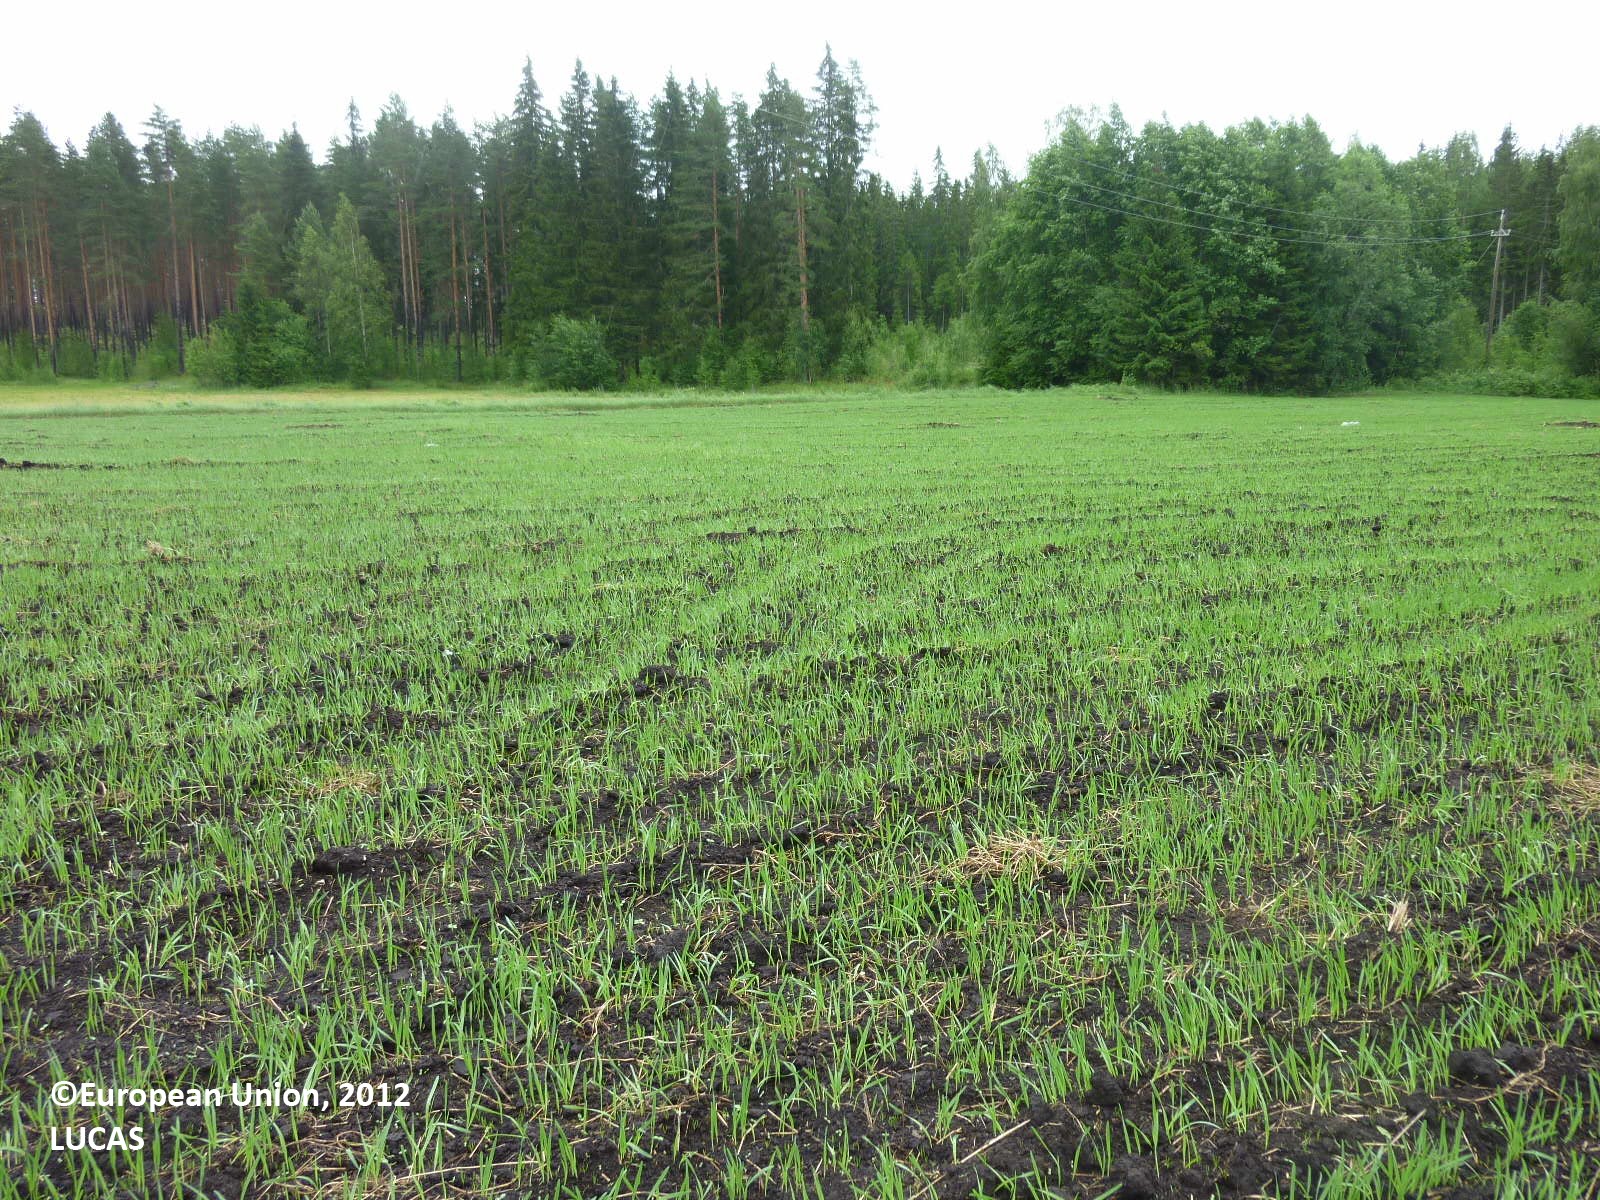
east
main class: Cropland
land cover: Oats
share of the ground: > 75 %
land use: Agriculture (excluding fallow land and kitchen gardens)
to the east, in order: Oats; Electric lines; Oats; Grassland with sparse tree/shrub cover; Ditches and canals; Temporary grasslands; Ditches and canals; Grassland with sparse tree/shrub cover; Spruce dominated coniferous woodland; Broadleaved woodland; Spruce dominated coniferous woodland; Pine dominated coniferous woodland; Tracks; Pine dominated coniferous woodland; Tracks; Pine dominated coniferous woodland
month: July
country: FI
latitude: 61.4651
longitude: 22.7340
